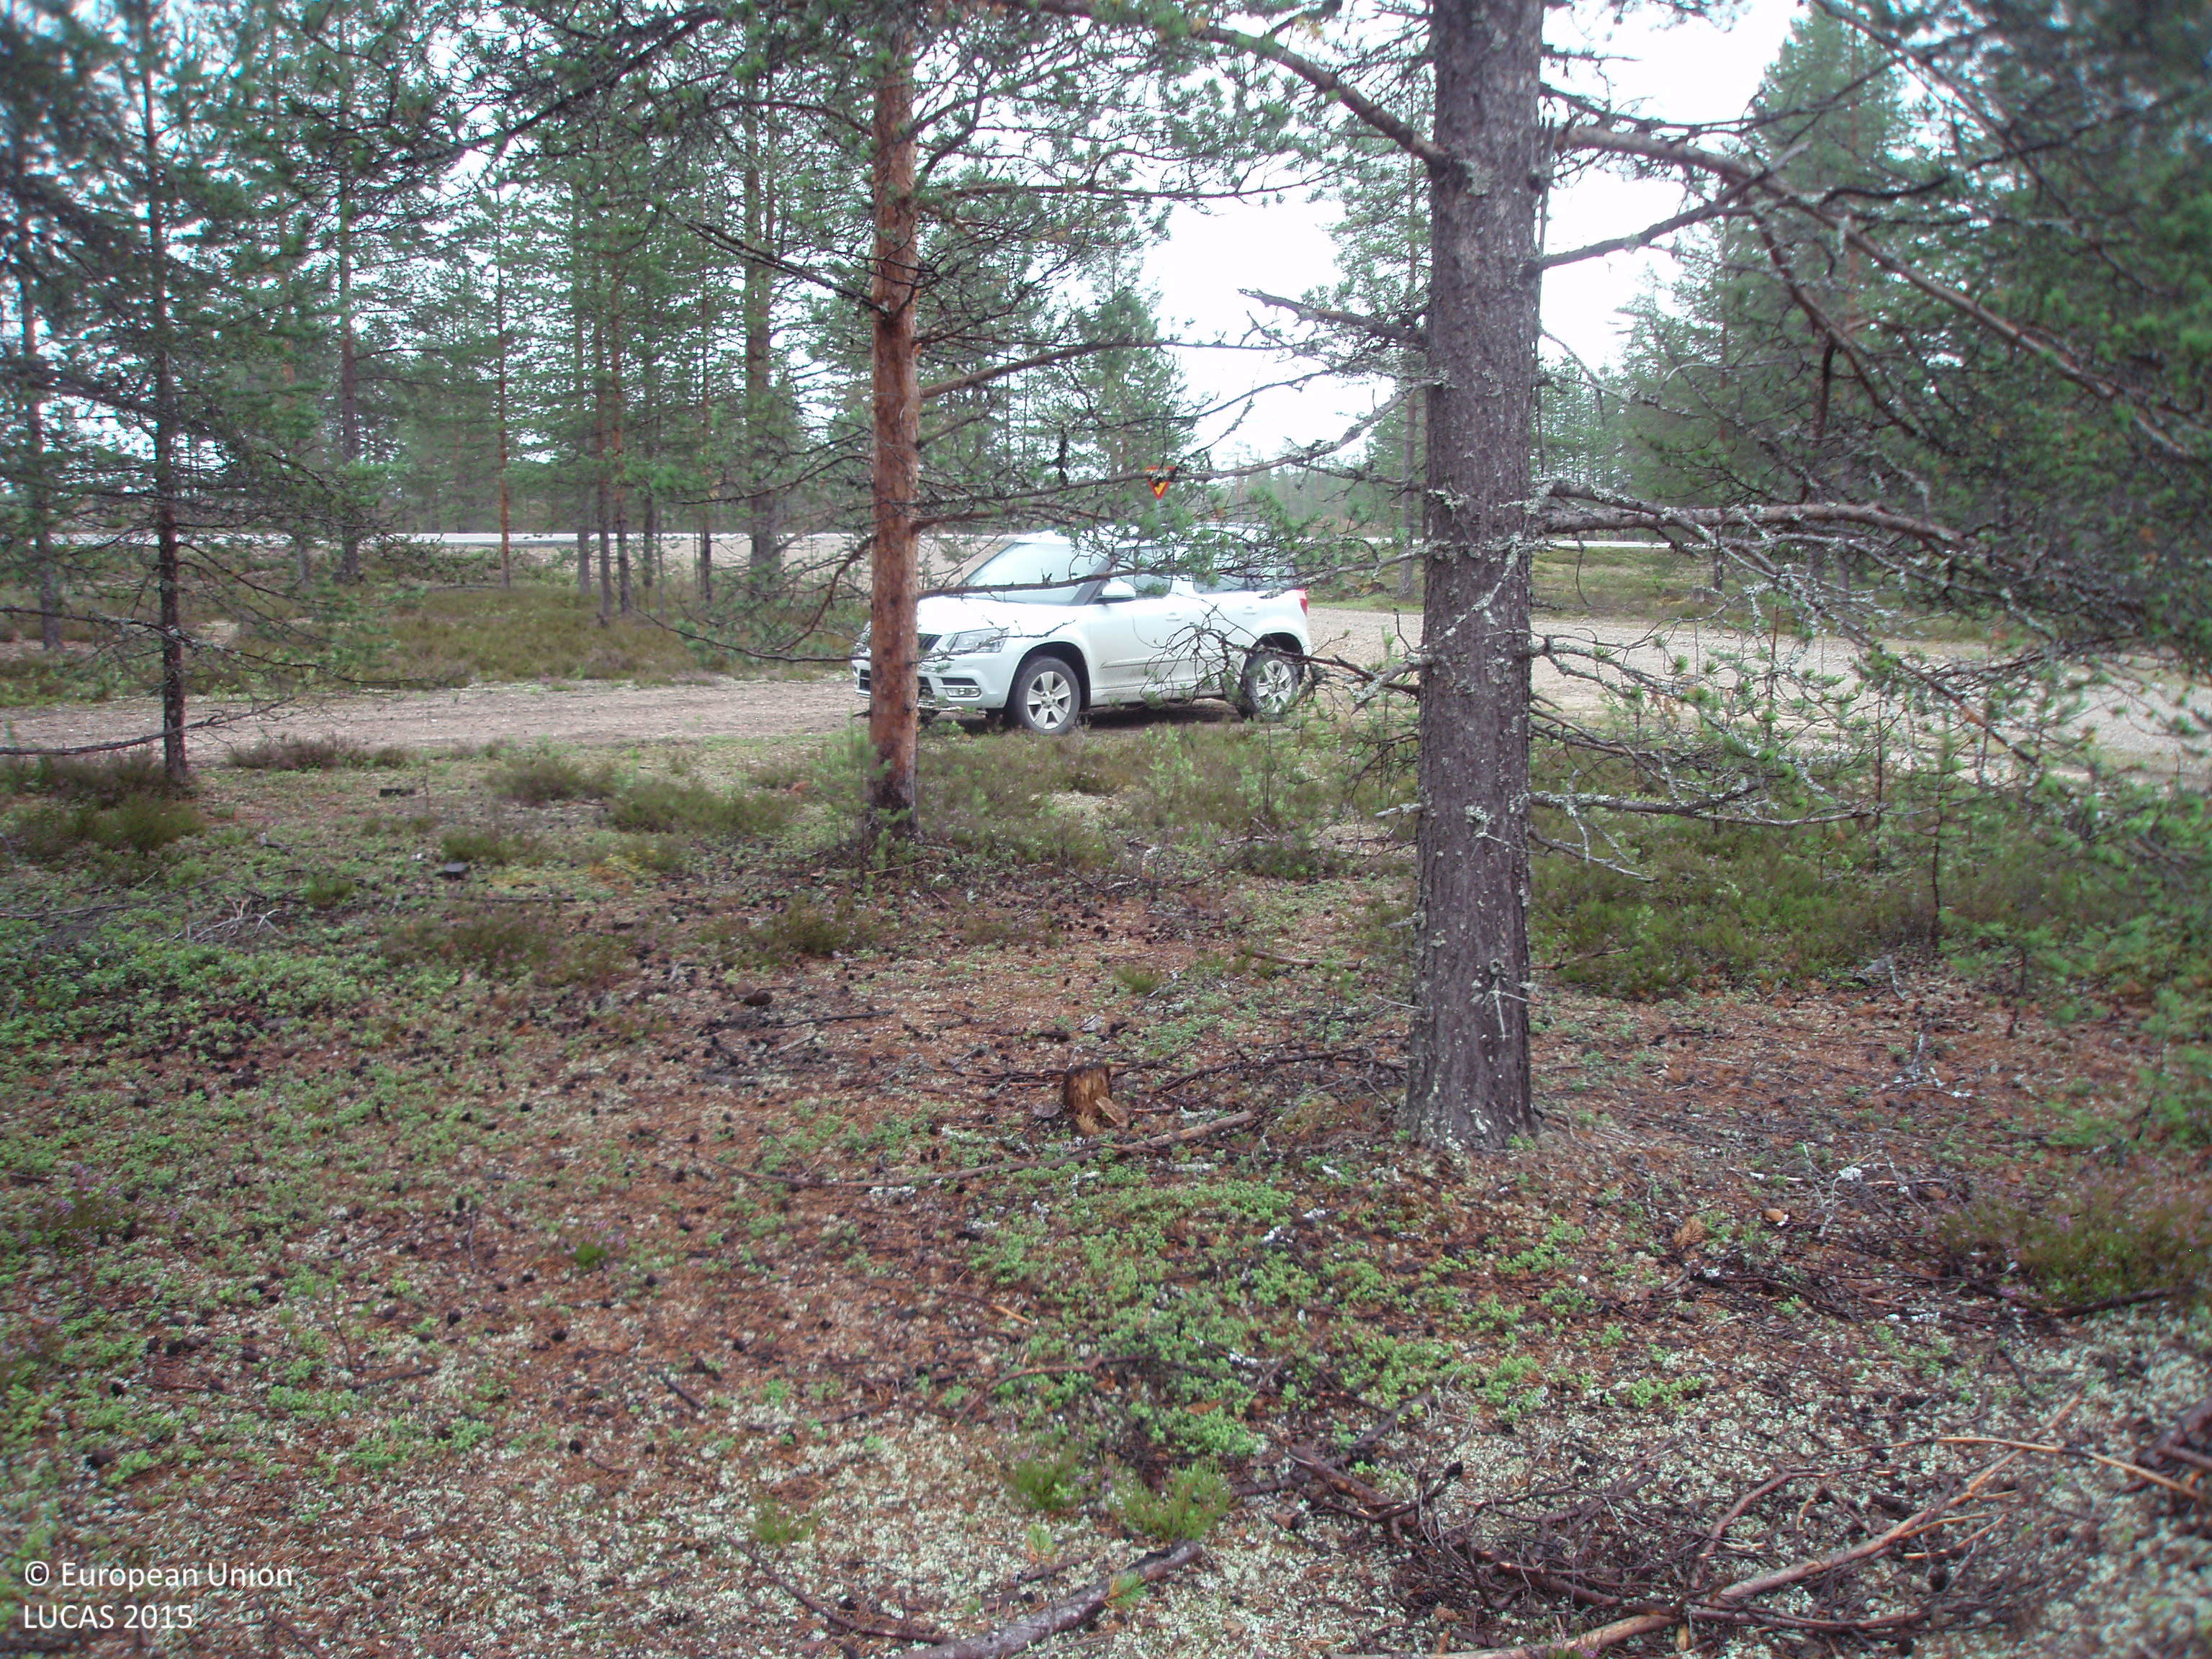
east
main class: Woodland
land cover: Pine dominated coniferous woodland
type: boreal forest
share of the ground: > 75 %
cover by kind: coniferous forest trees 75 %, shrubs 25 %
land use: Forestry
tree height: > 5 m
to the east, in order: Pine dominated coniferous woodland; Tracks; Pine dominated coniferous woodland; Ditches and canals; Paved roads, cycling and walking lanes; Tracks; Sand; Single bushes/trees; Sand; Single bushes/trees; Shruby margins; Sand; Pine dominated coniferous woodland; Shrubland without tree cover; Tracks; Shrubland without tree cover
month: August
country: FI
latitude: 65.6625
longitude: 27.3679
